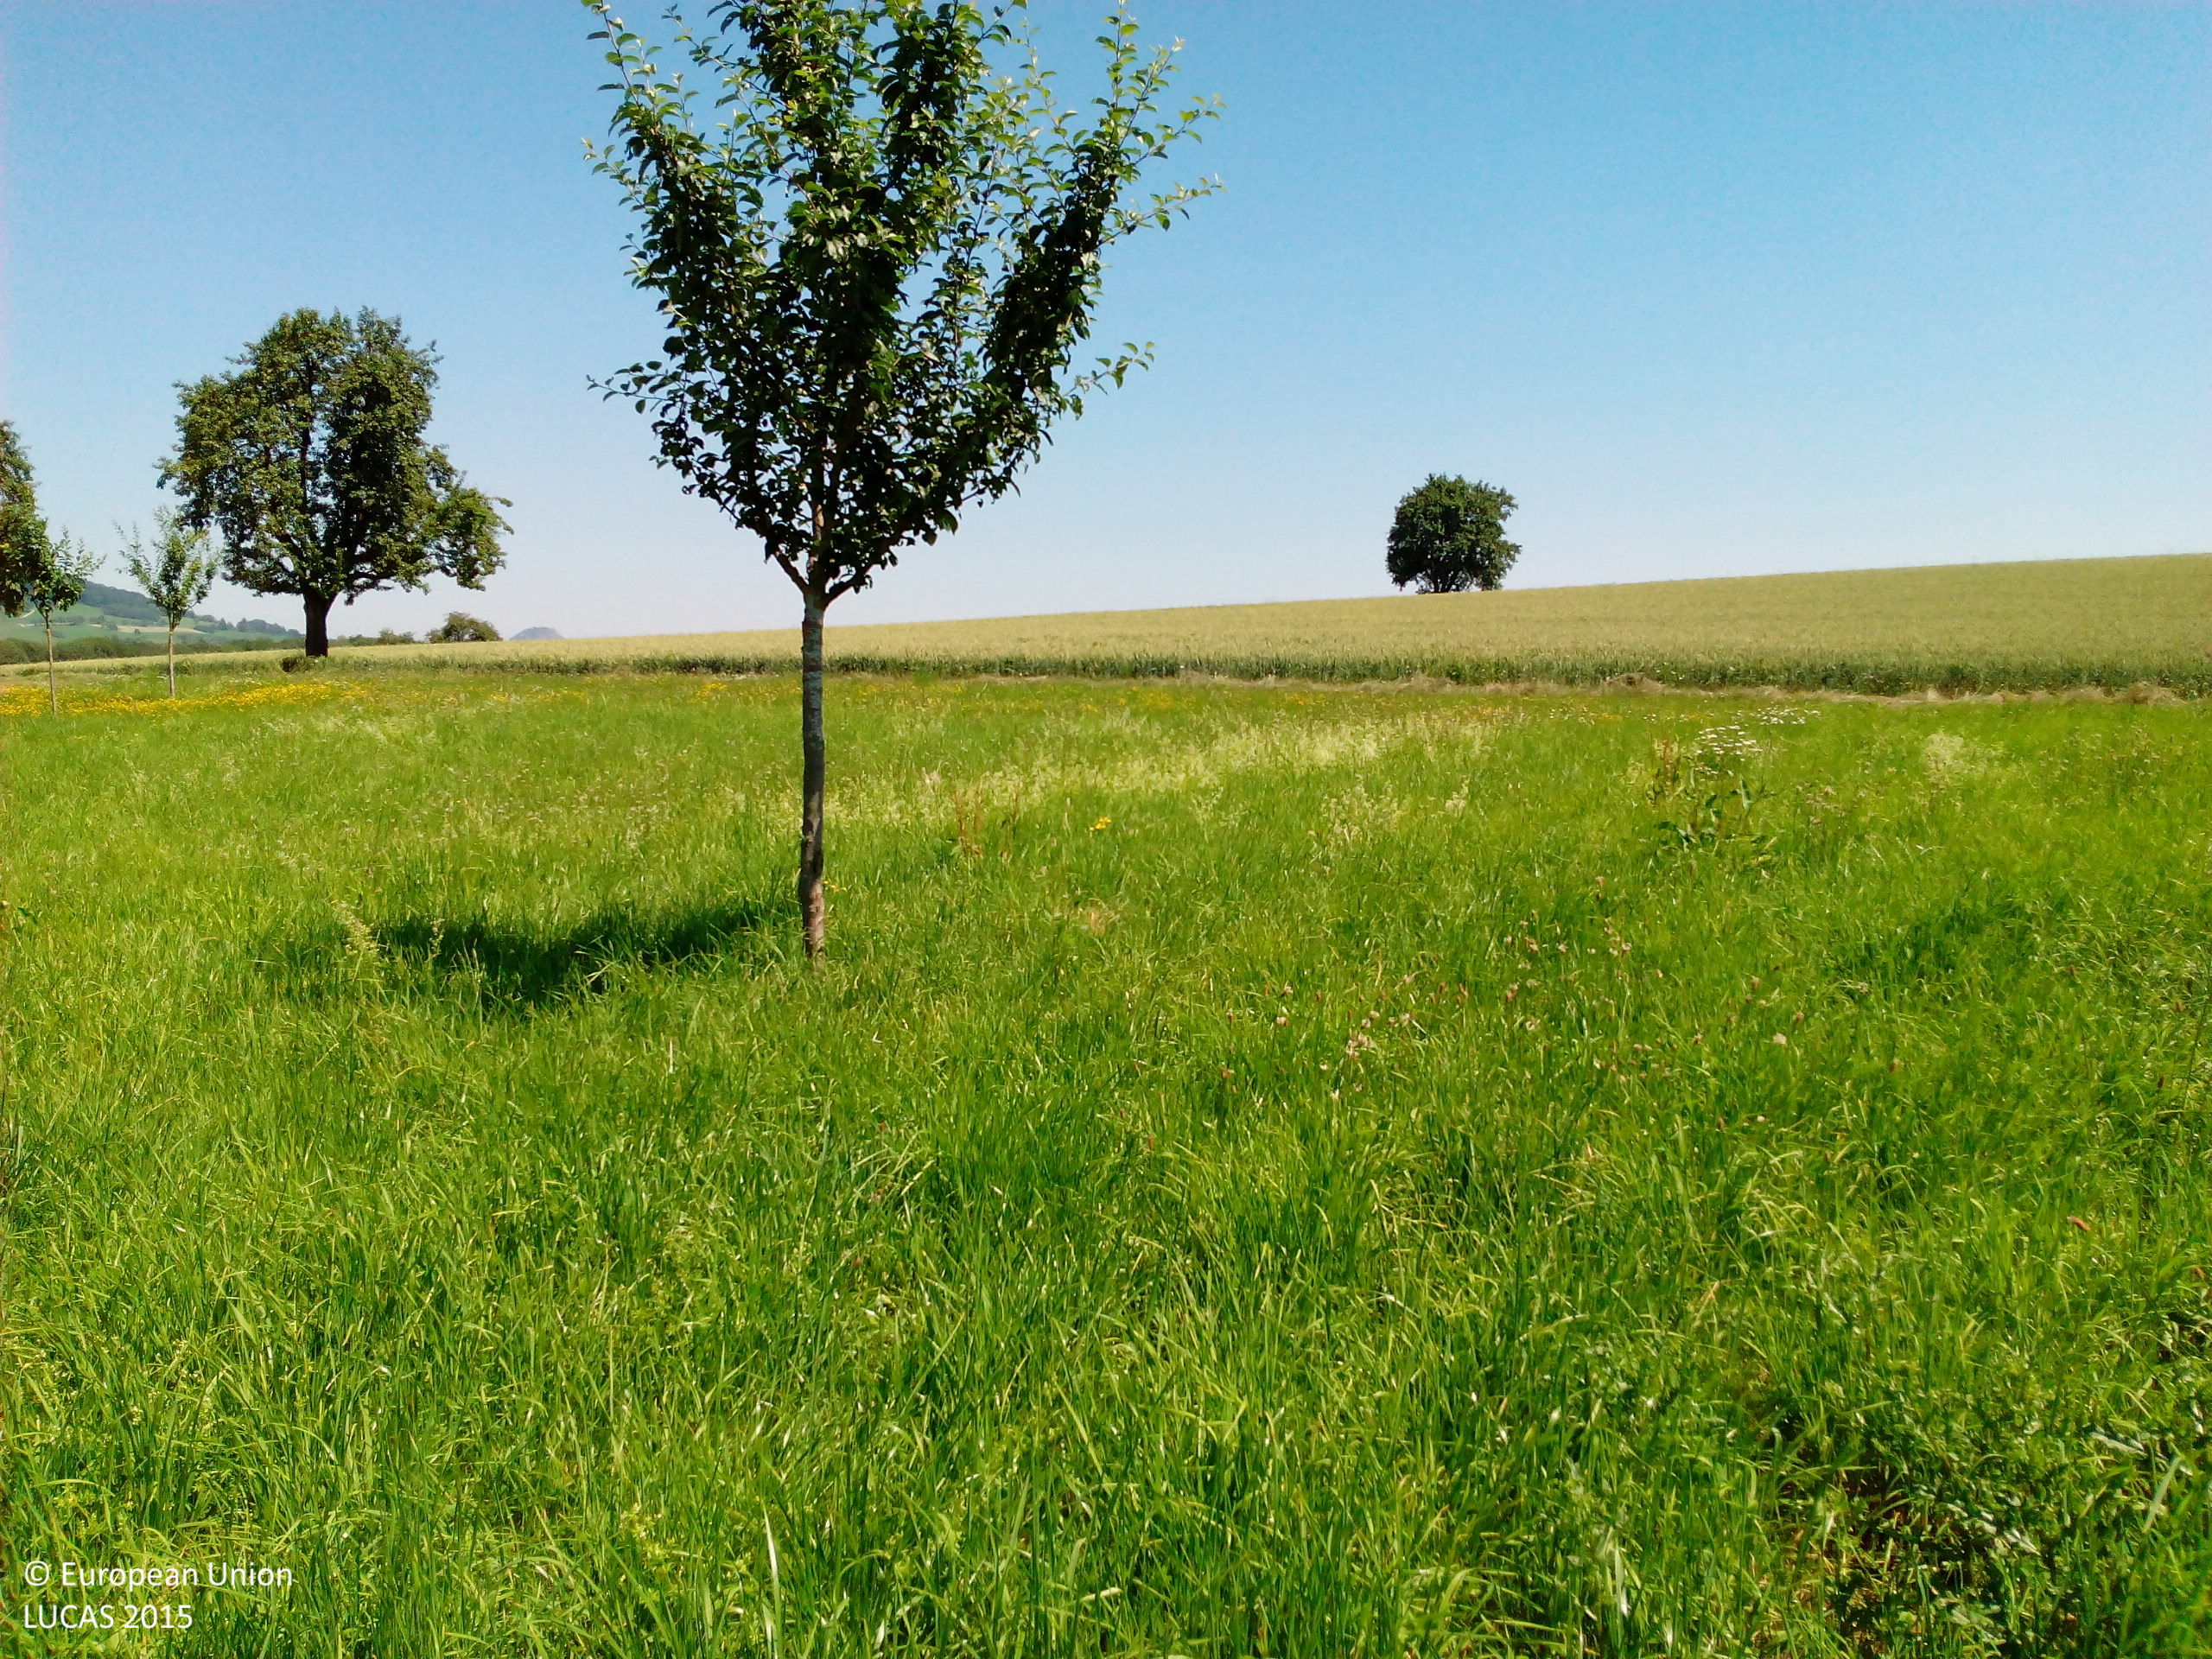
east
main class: Cropland
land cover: Maize
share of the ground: > 75 %
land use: Agriculture (excluding fallow land and kitchen gardens)
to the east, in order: Maize; Grassland with sparse tree/shrub cover; Artificial constructions in urban areas; Grassland without tree/shrub cover; Tracks; Pear fruit; Grass margins; Common wheat; Paved roads, cycling and walking lanes; Temporary grasslands
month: July
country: DE
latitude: 47.7660
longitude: 8.7067
